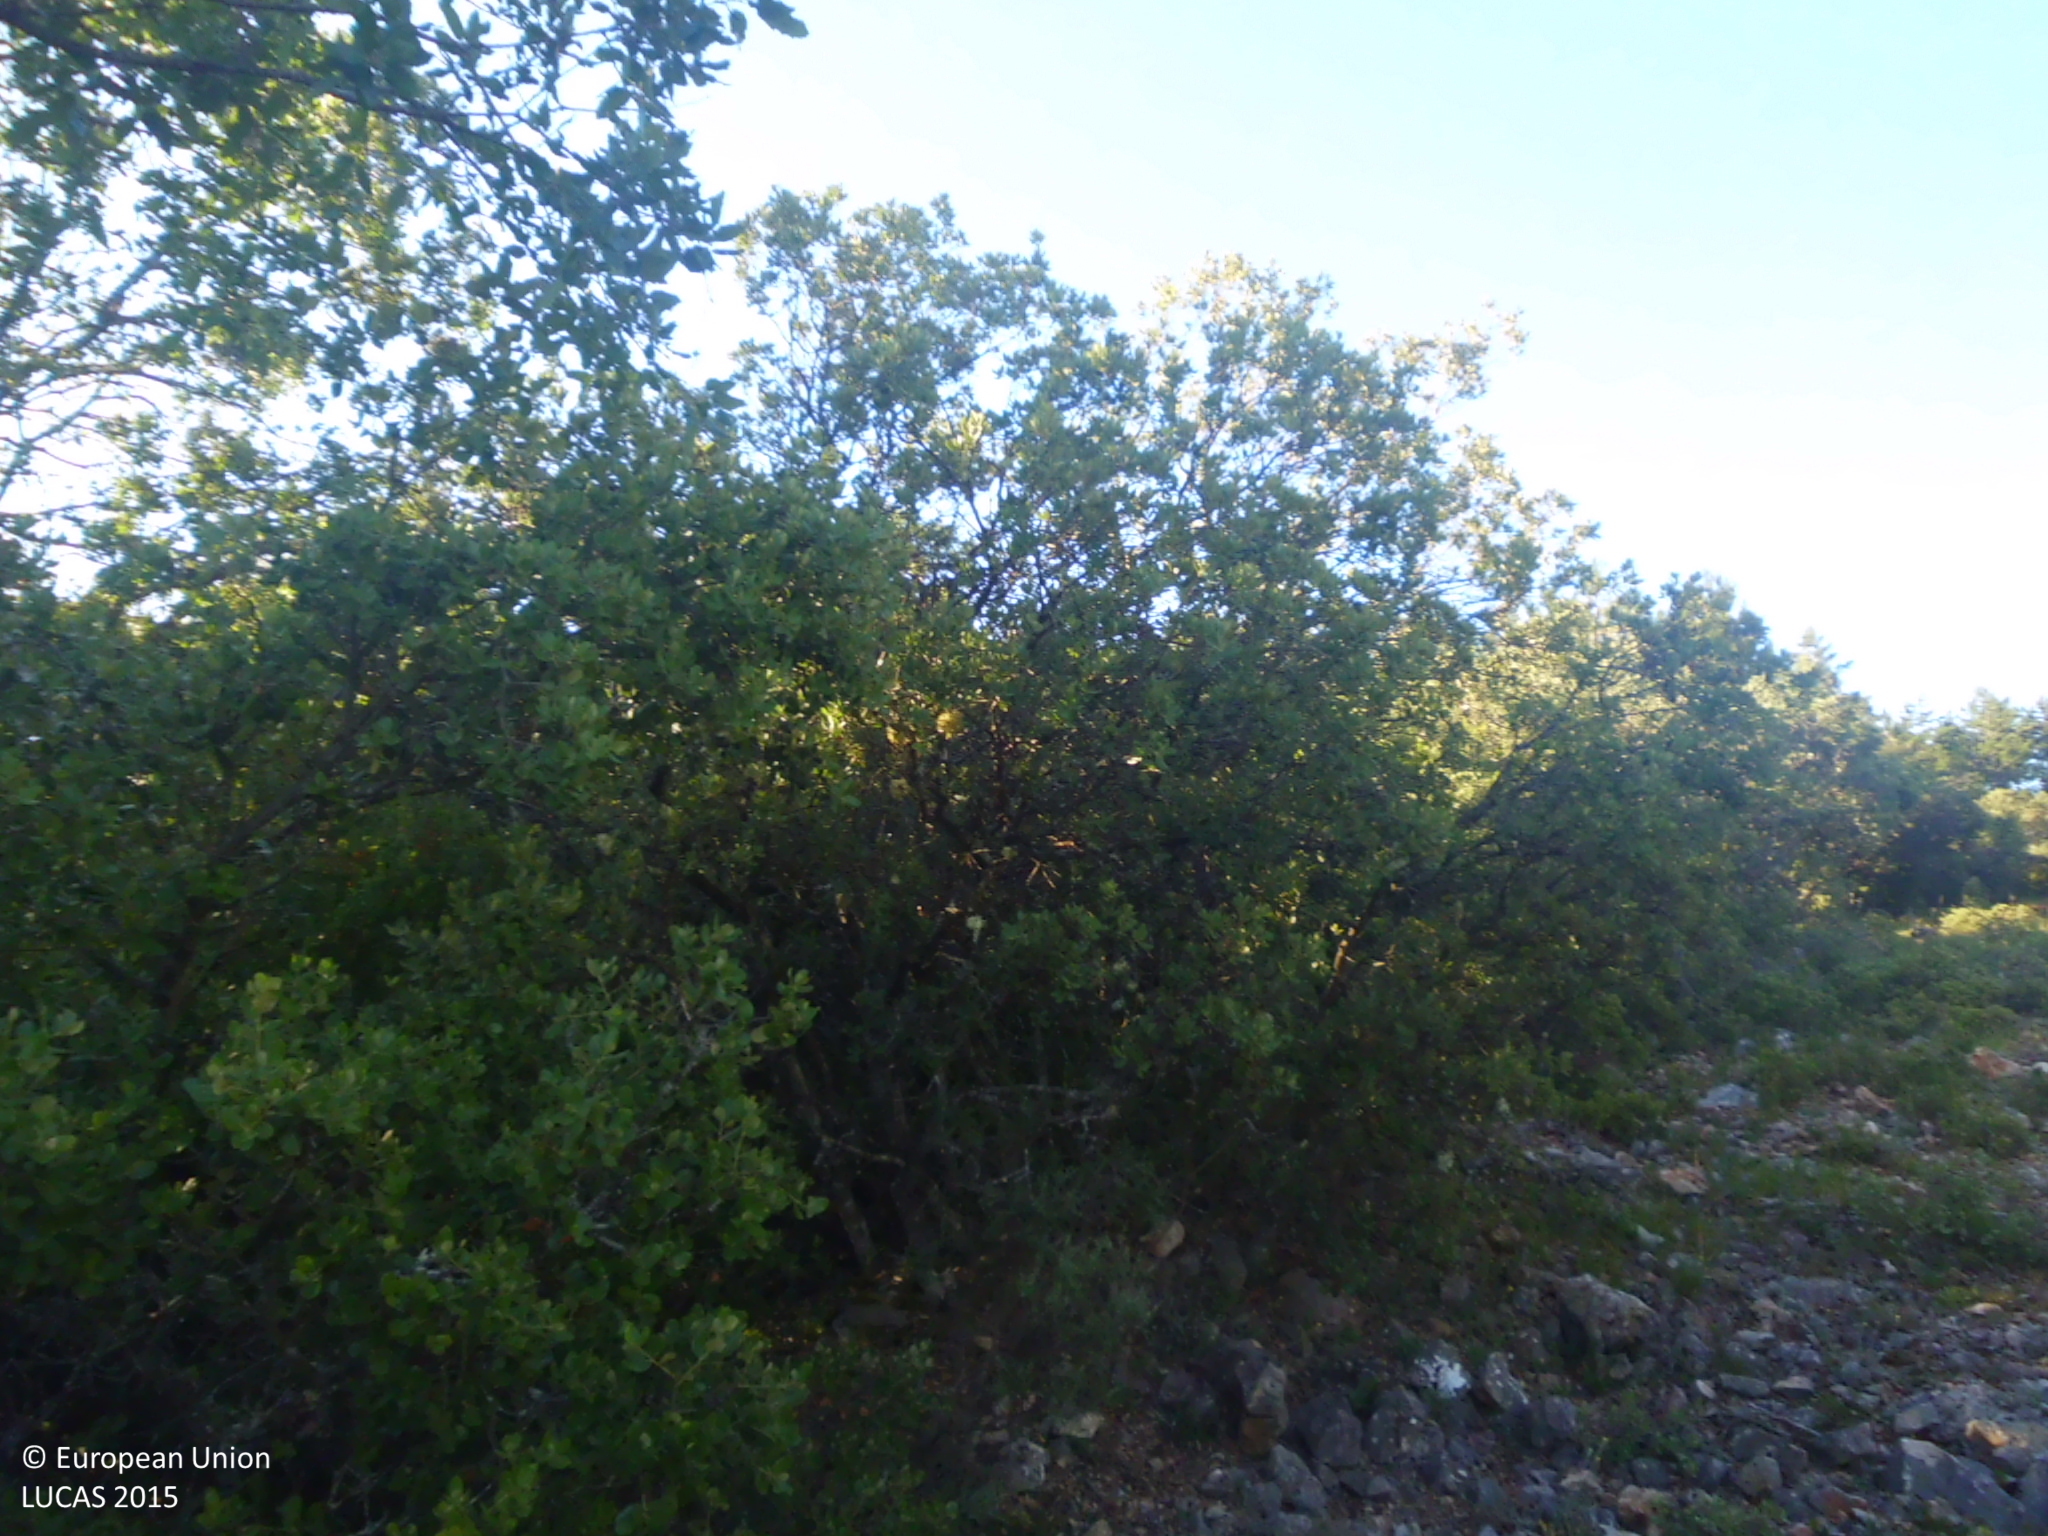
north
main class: Woodland
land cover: Broadleaved woodland
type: broadleaved evergreen forest
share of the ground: > 75 %
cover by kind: broadleaved forest trees 80 %, shrubs 20 %
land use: Forestry
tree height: > 5 m
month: June
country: ES
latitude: 42.7477
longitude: -3.3888
